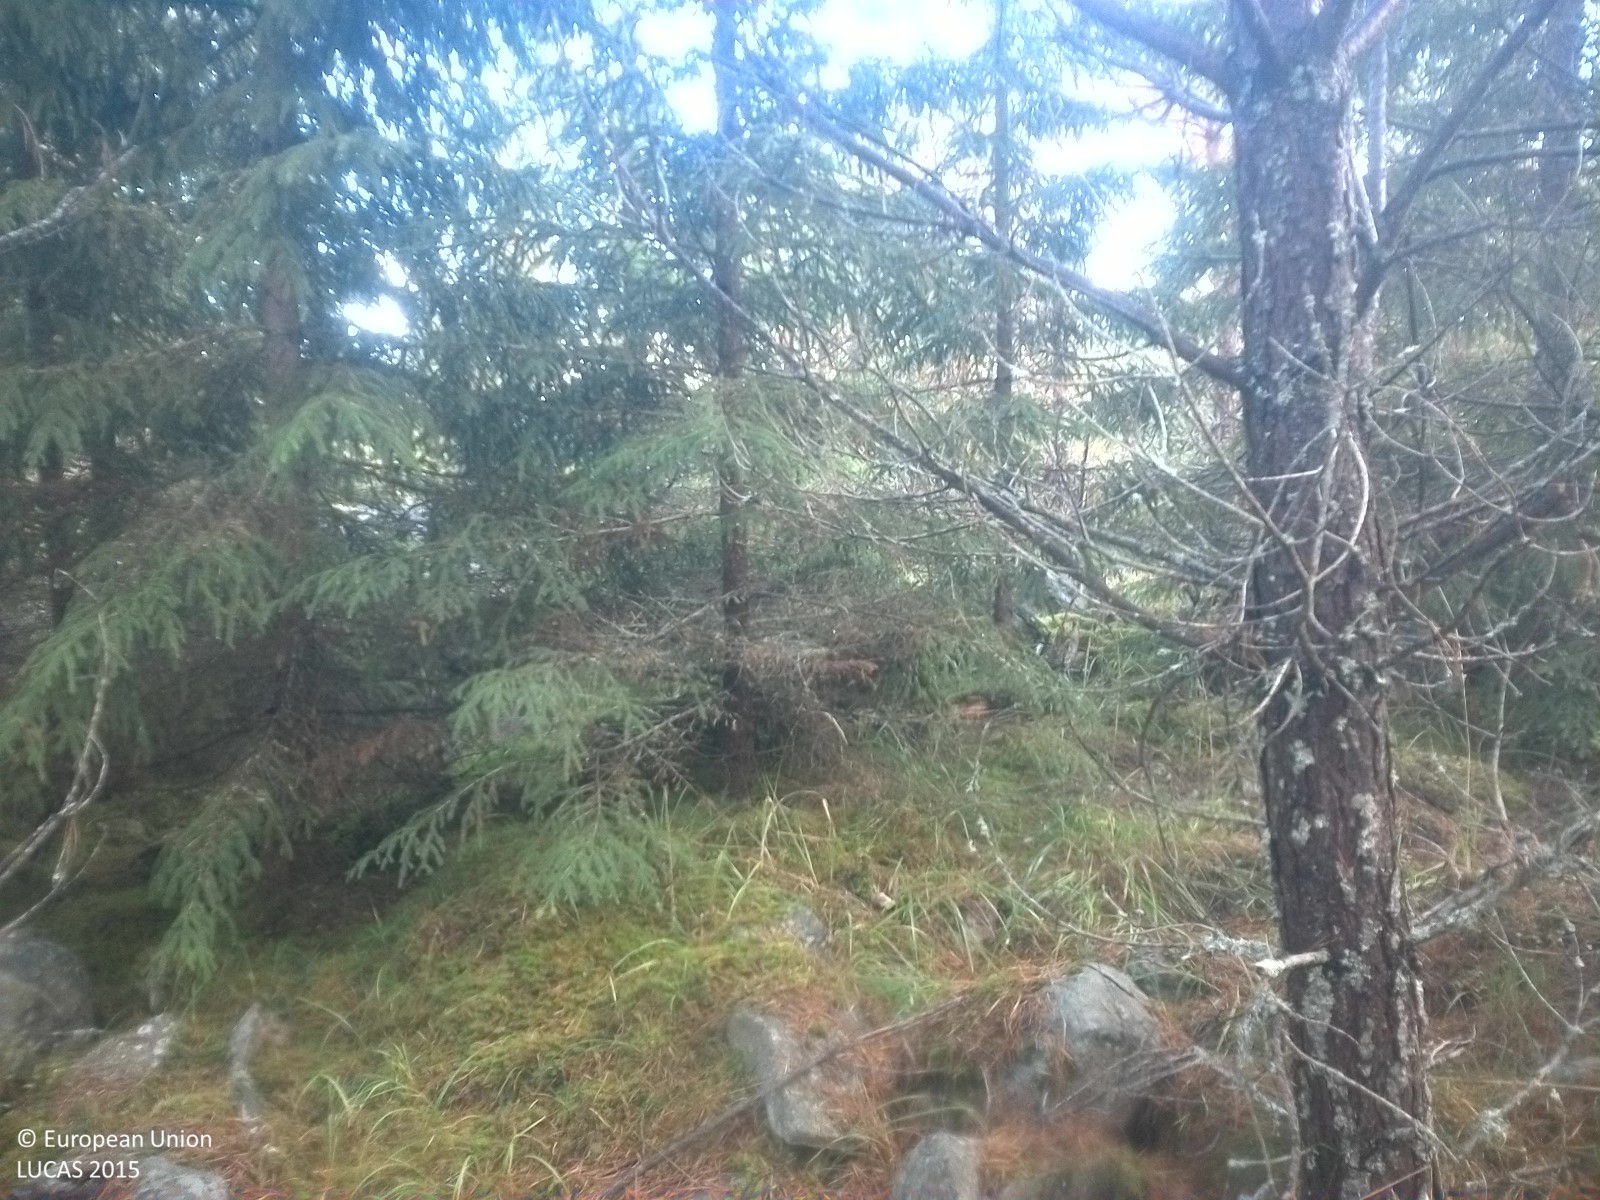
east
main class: Woodland
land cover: Pine dominated coniferous woodland
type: boreal forest
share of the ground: 50 - 75 %
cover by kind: coniferous forest trees 60 %, lichens and mosses 25 %, herbaceous plants 15 %
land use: Forestry
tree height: < 5 m
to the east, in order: Pine dominated coniferous woodland; Spruce dominated coniferous woodland; Ditches and canals; Spruce dominated coniferous woodland; Grass margins; Paved roads, cycling and walking lanes; Ditches and canals; Spruce dominated coniferous woodland; Pine dominated coniferous woodland; Lichens and moss; Pine dominated coniferous woodland
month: September
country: SE
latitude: 58.7950
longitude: 16.2761
